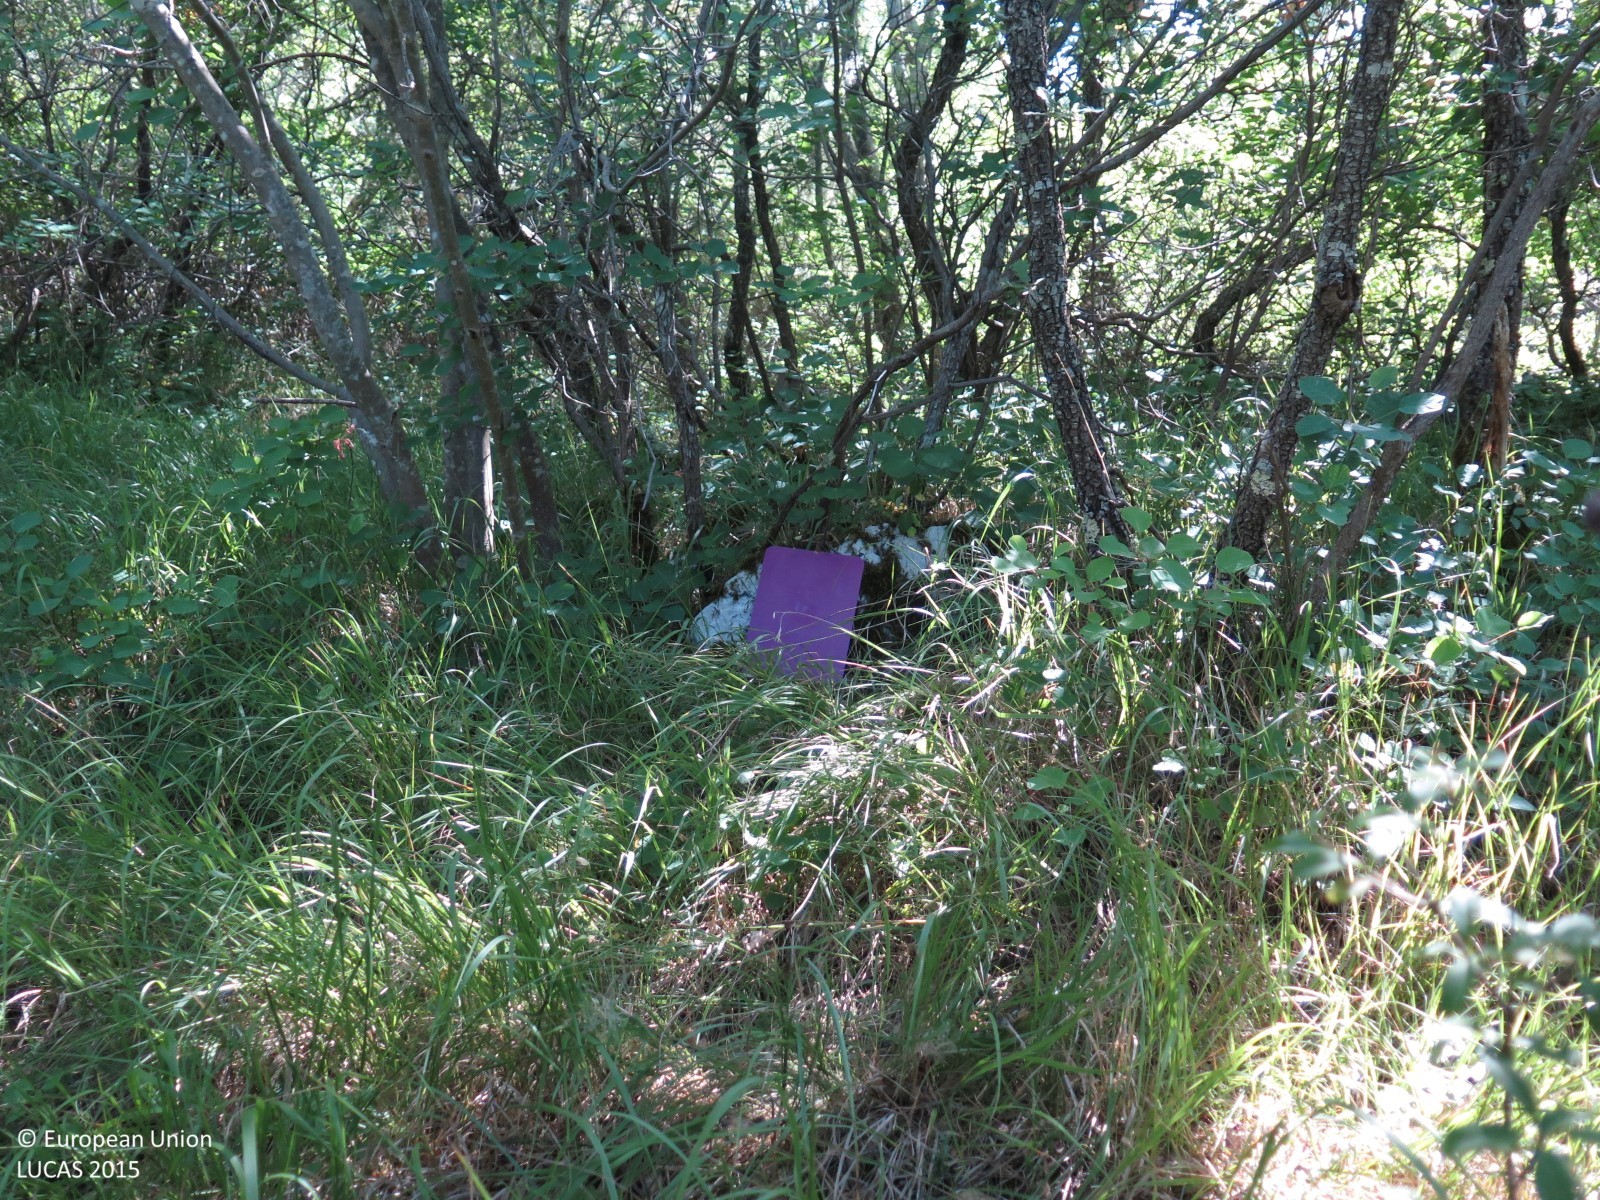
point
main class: Woodland
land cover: Broadleaved woodland
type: acidophilous oak and oak-birch forest
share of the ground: > 75 %
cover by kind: broadleaved forest trees 95 %, herbaceous plants 5 %
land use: Semi-natural and natural areas not in use
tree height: > 5 m
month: July
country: HR
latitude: 45.4211
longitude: 13.7141
